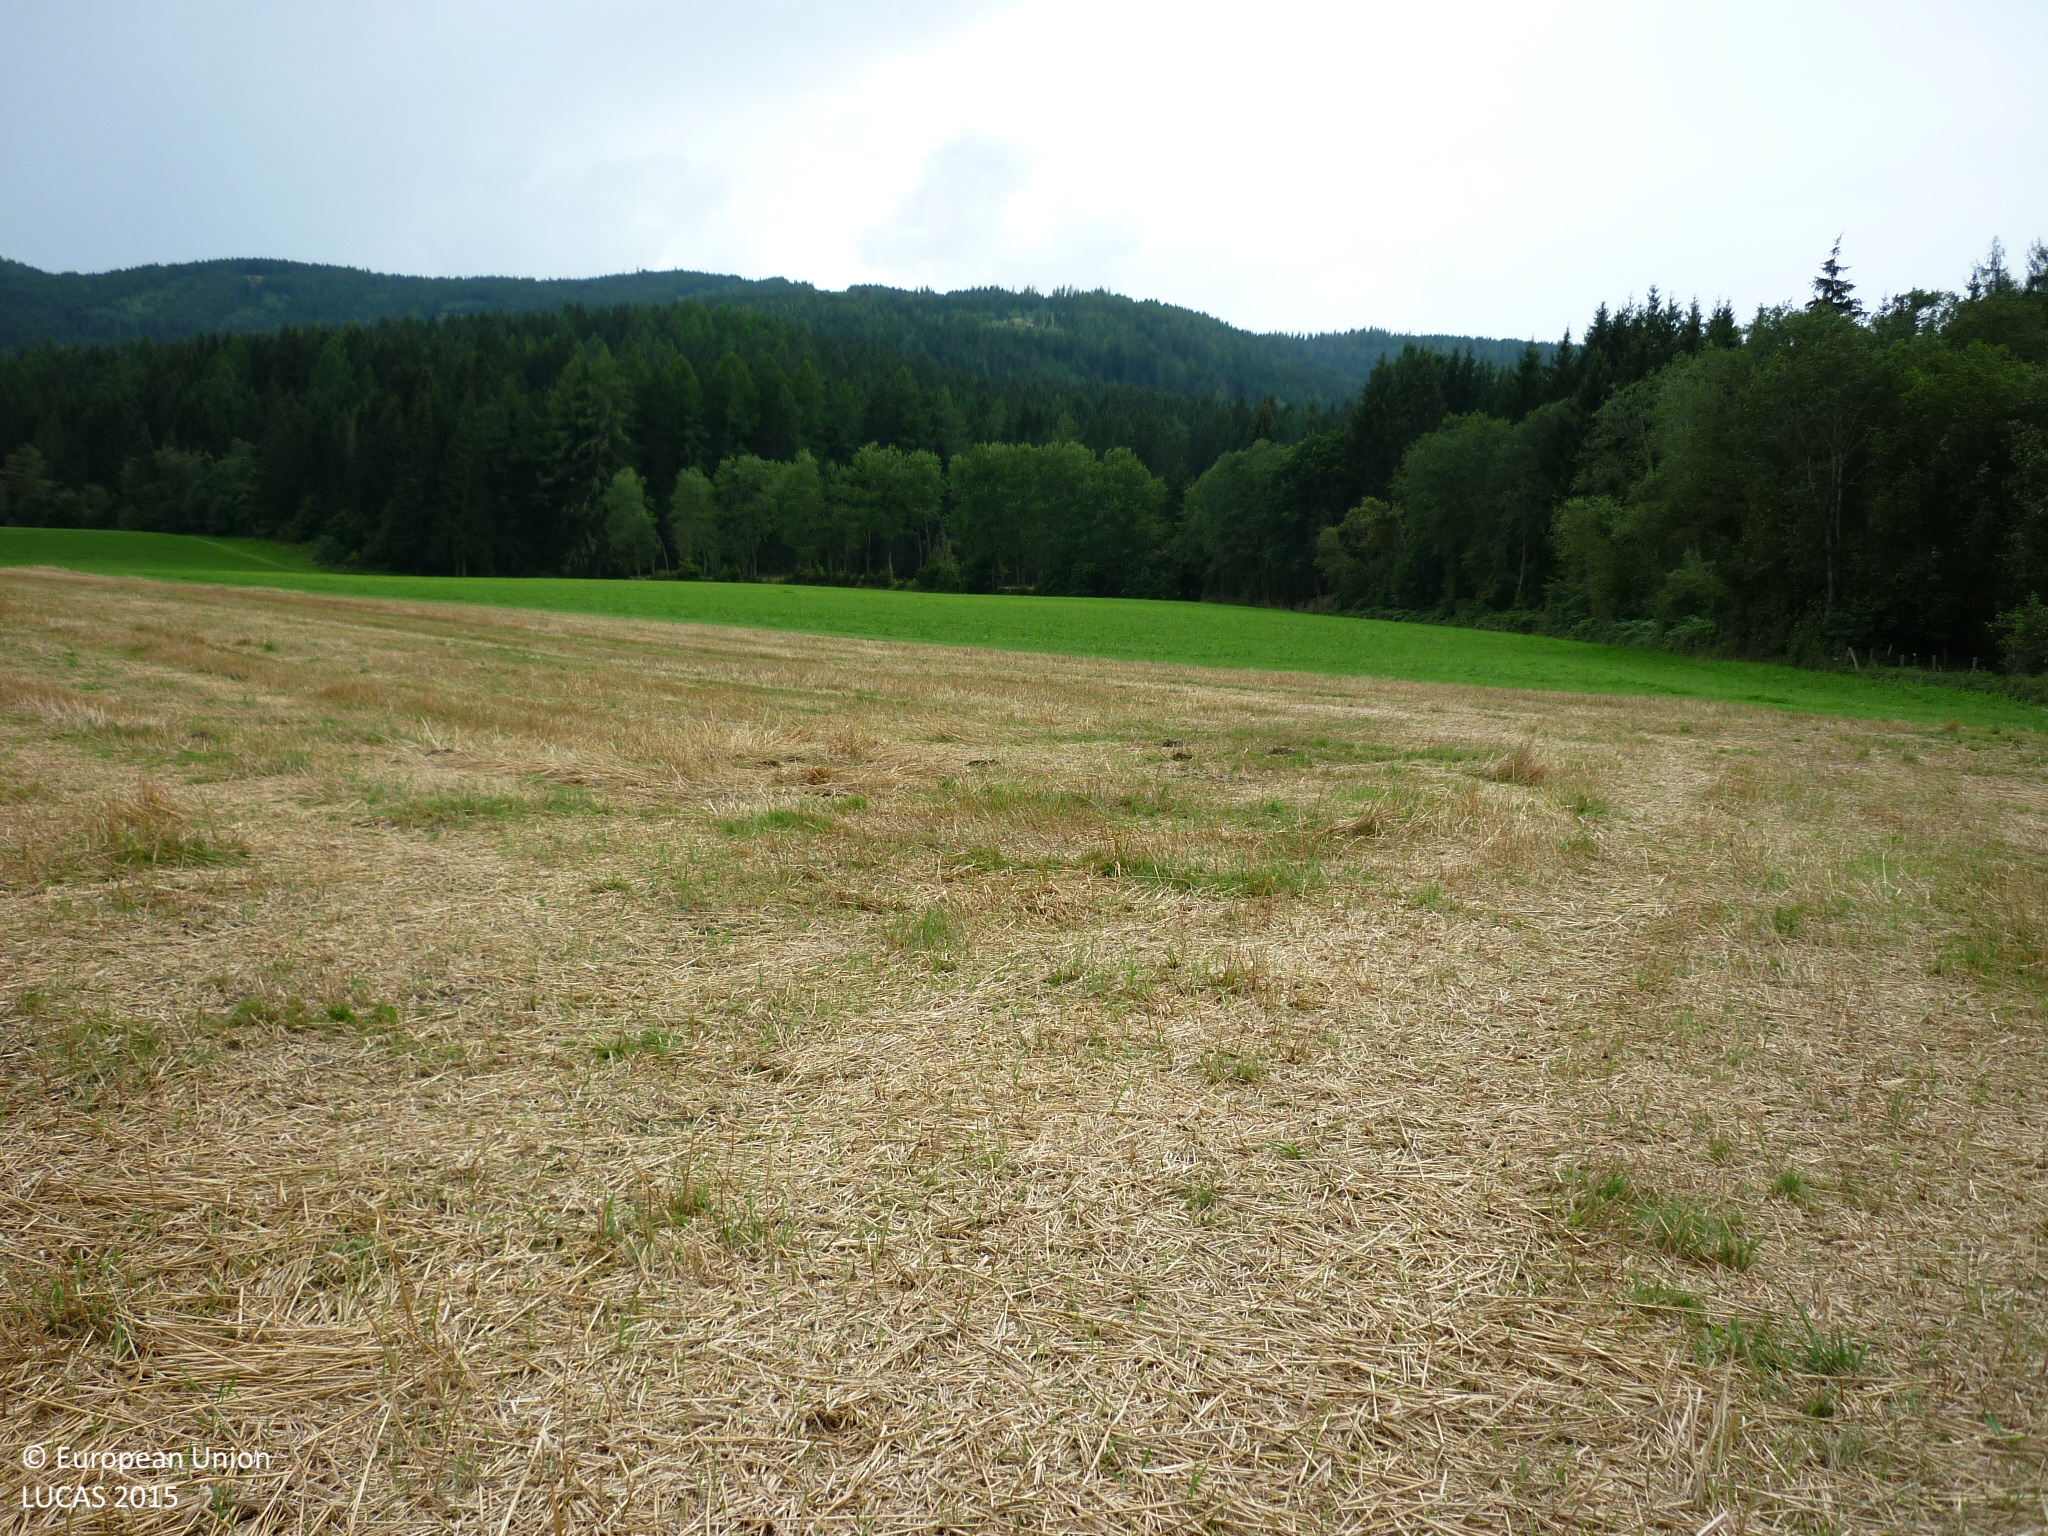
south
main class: Cropland
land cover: Common wheat
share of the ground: > 75 %
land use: Agriculture (excluding fallow land and kitchen gardens)
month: August
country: AT
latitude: 47.0147
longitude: 14.4841
